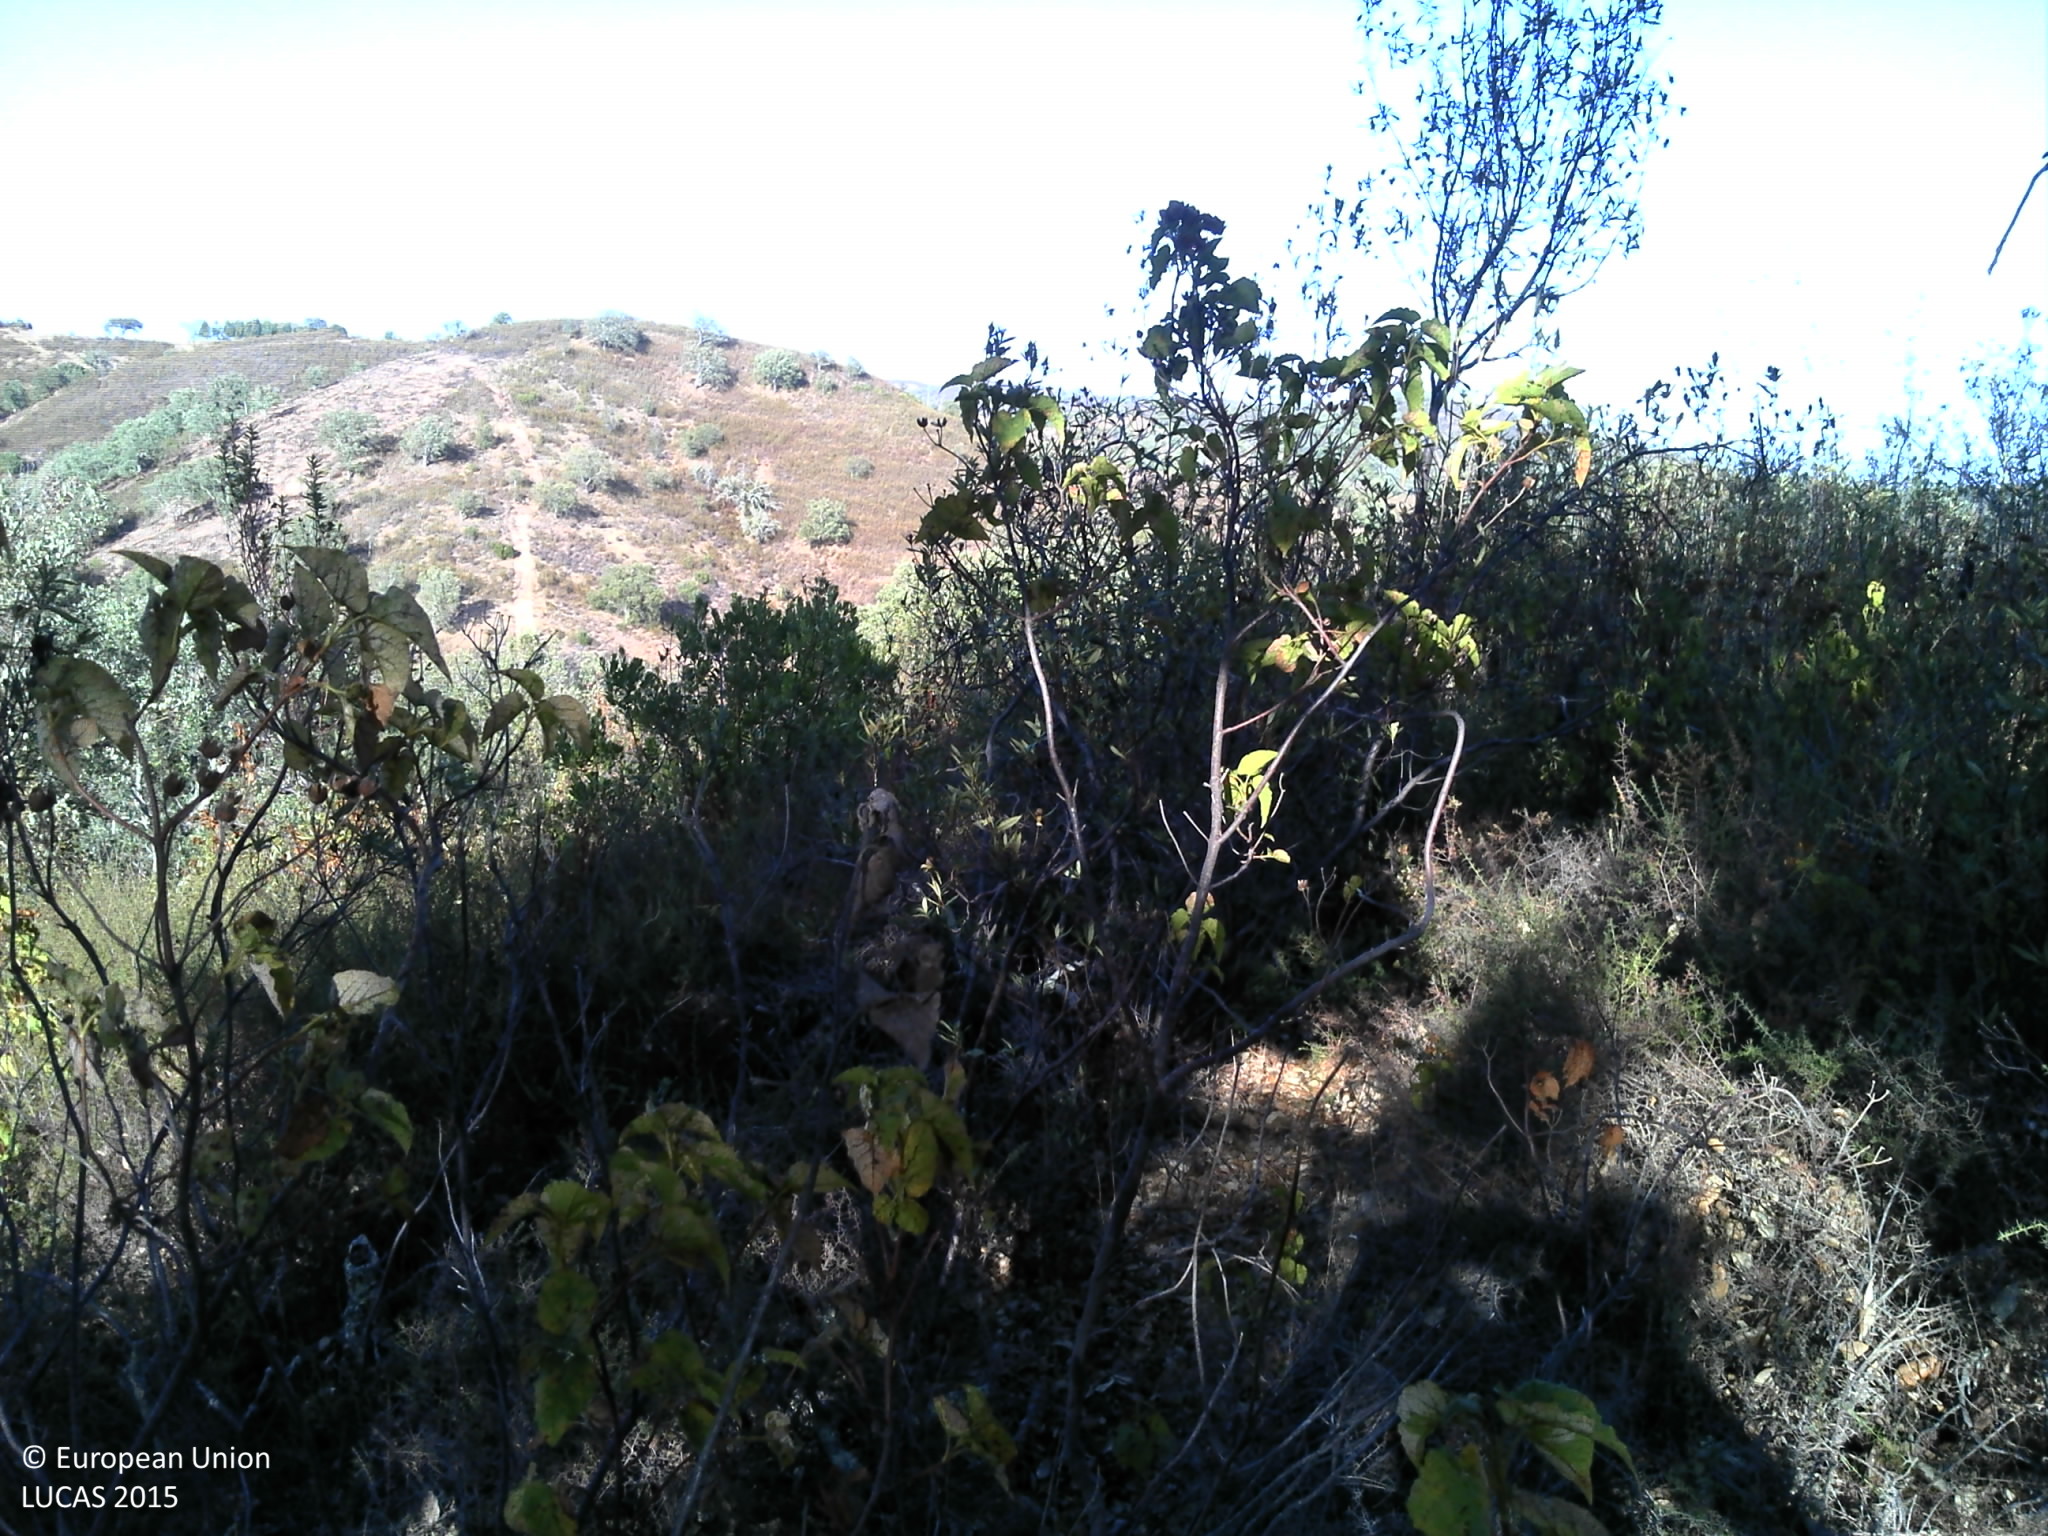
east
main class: Woodland
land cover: Broadleaved woodland
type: broadleaved evergreen forest
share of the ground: 25 - 50 %
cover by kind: broadleaved forest trees 40 %, shrubs 40 %, herbaceous plants 10 %, unconsolidated bare surface 10 %
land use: Forestry
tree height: > 5 m
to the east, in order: Broadleaved woodland; Shrubland without tree cover; Broadleaved woodland; Grassland without tree/shrub cover; Broadleaved woodland
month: September
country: PT
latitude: 37.4282
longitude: -8.2529
